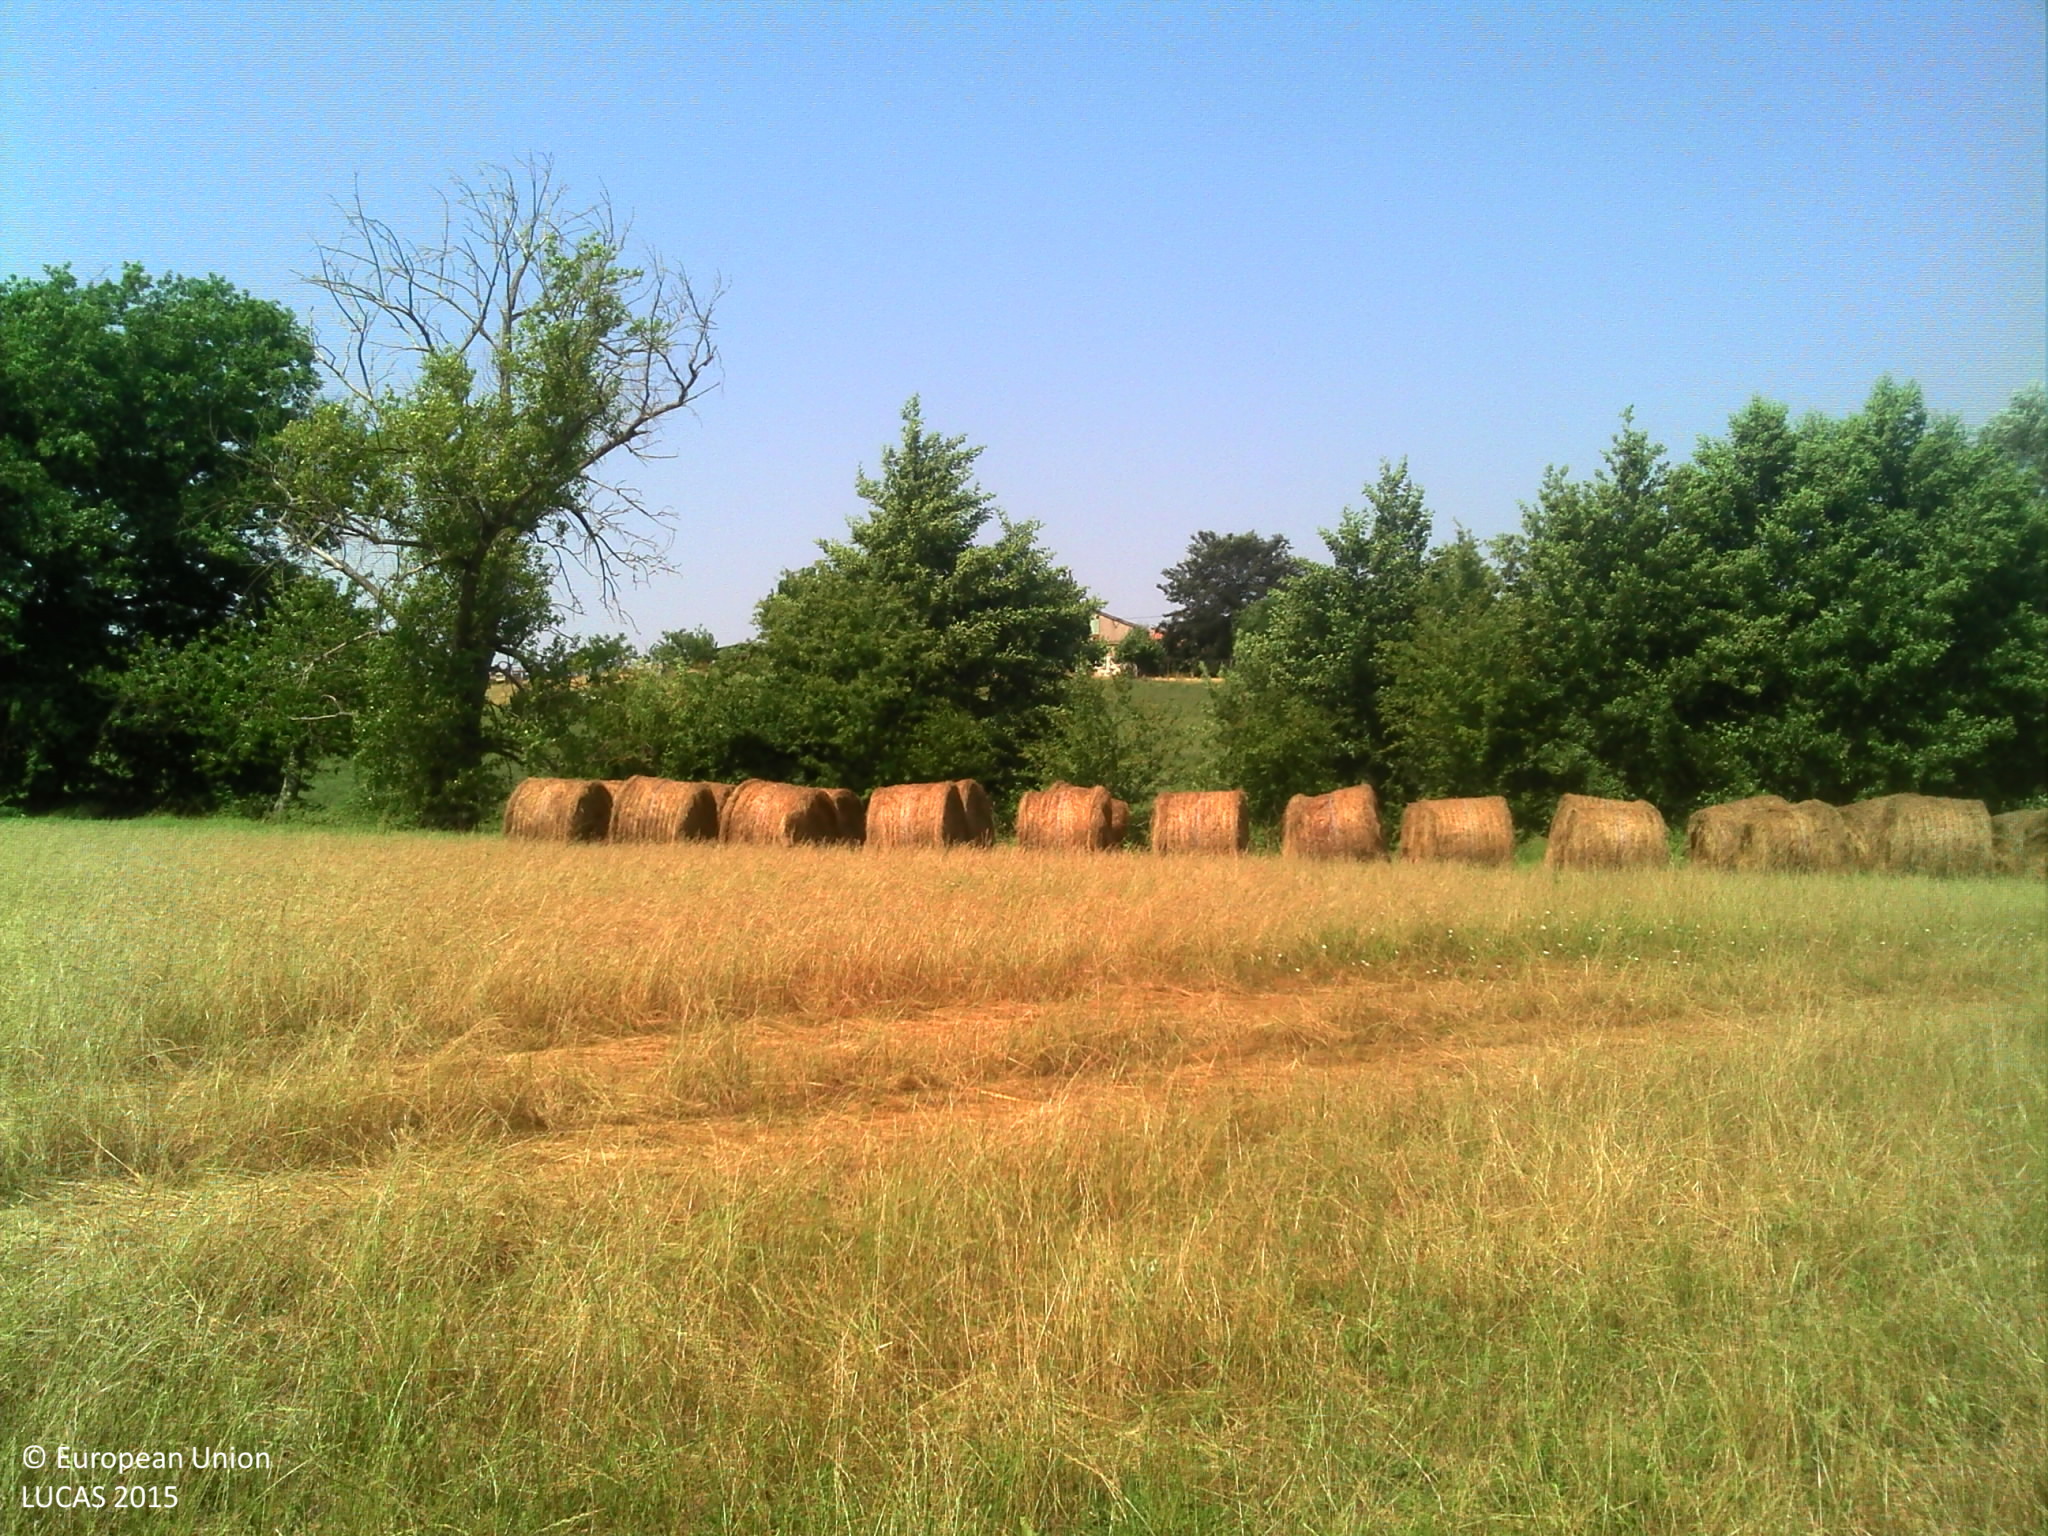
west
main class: Grassland
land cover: Grassland without tree/shrub cover
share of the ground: > 75 %
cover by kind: herbaceous plants 100 %
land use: Agriculture (excluding fallow land and kitchen gardens)
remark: Harvested field
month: July
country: FR
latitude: 43.3471
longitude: 1.0583
